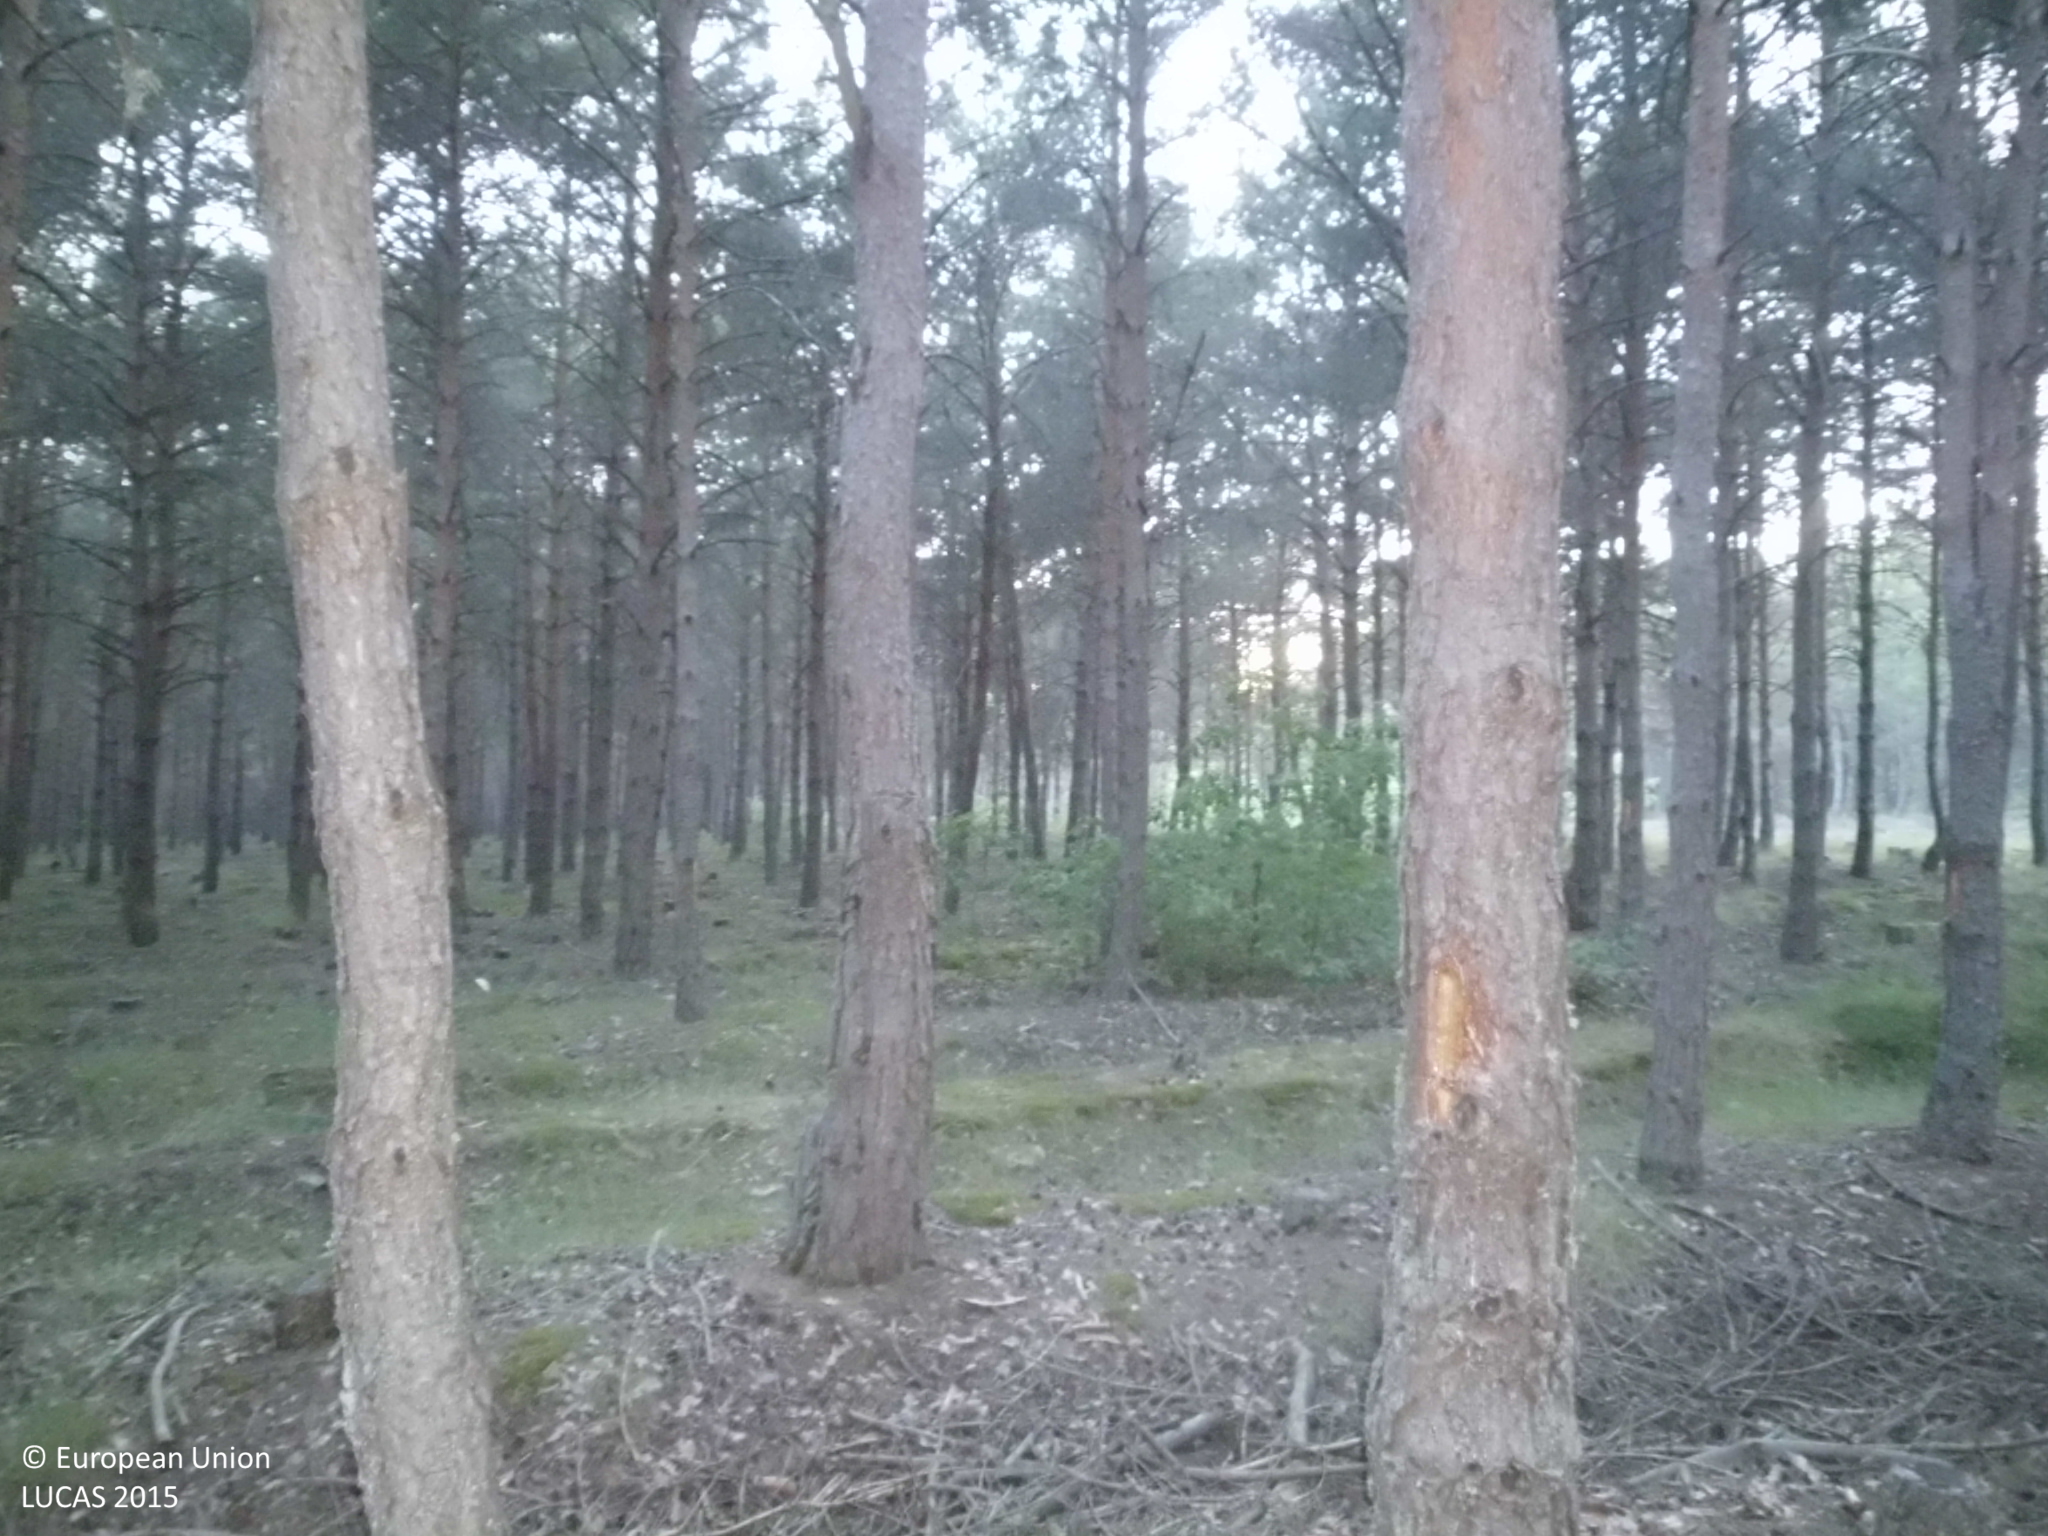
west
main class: Woodland
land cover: Pine dominated coniferous woodland
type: coniferous forest of the mediterranean region
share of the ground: > 75 %
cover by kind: coniferous forest trees 100 %
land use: Forestry
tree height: > 5 m
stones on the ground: > 50 %
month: May
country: ES
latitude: 42.5983
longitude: -4.8420
